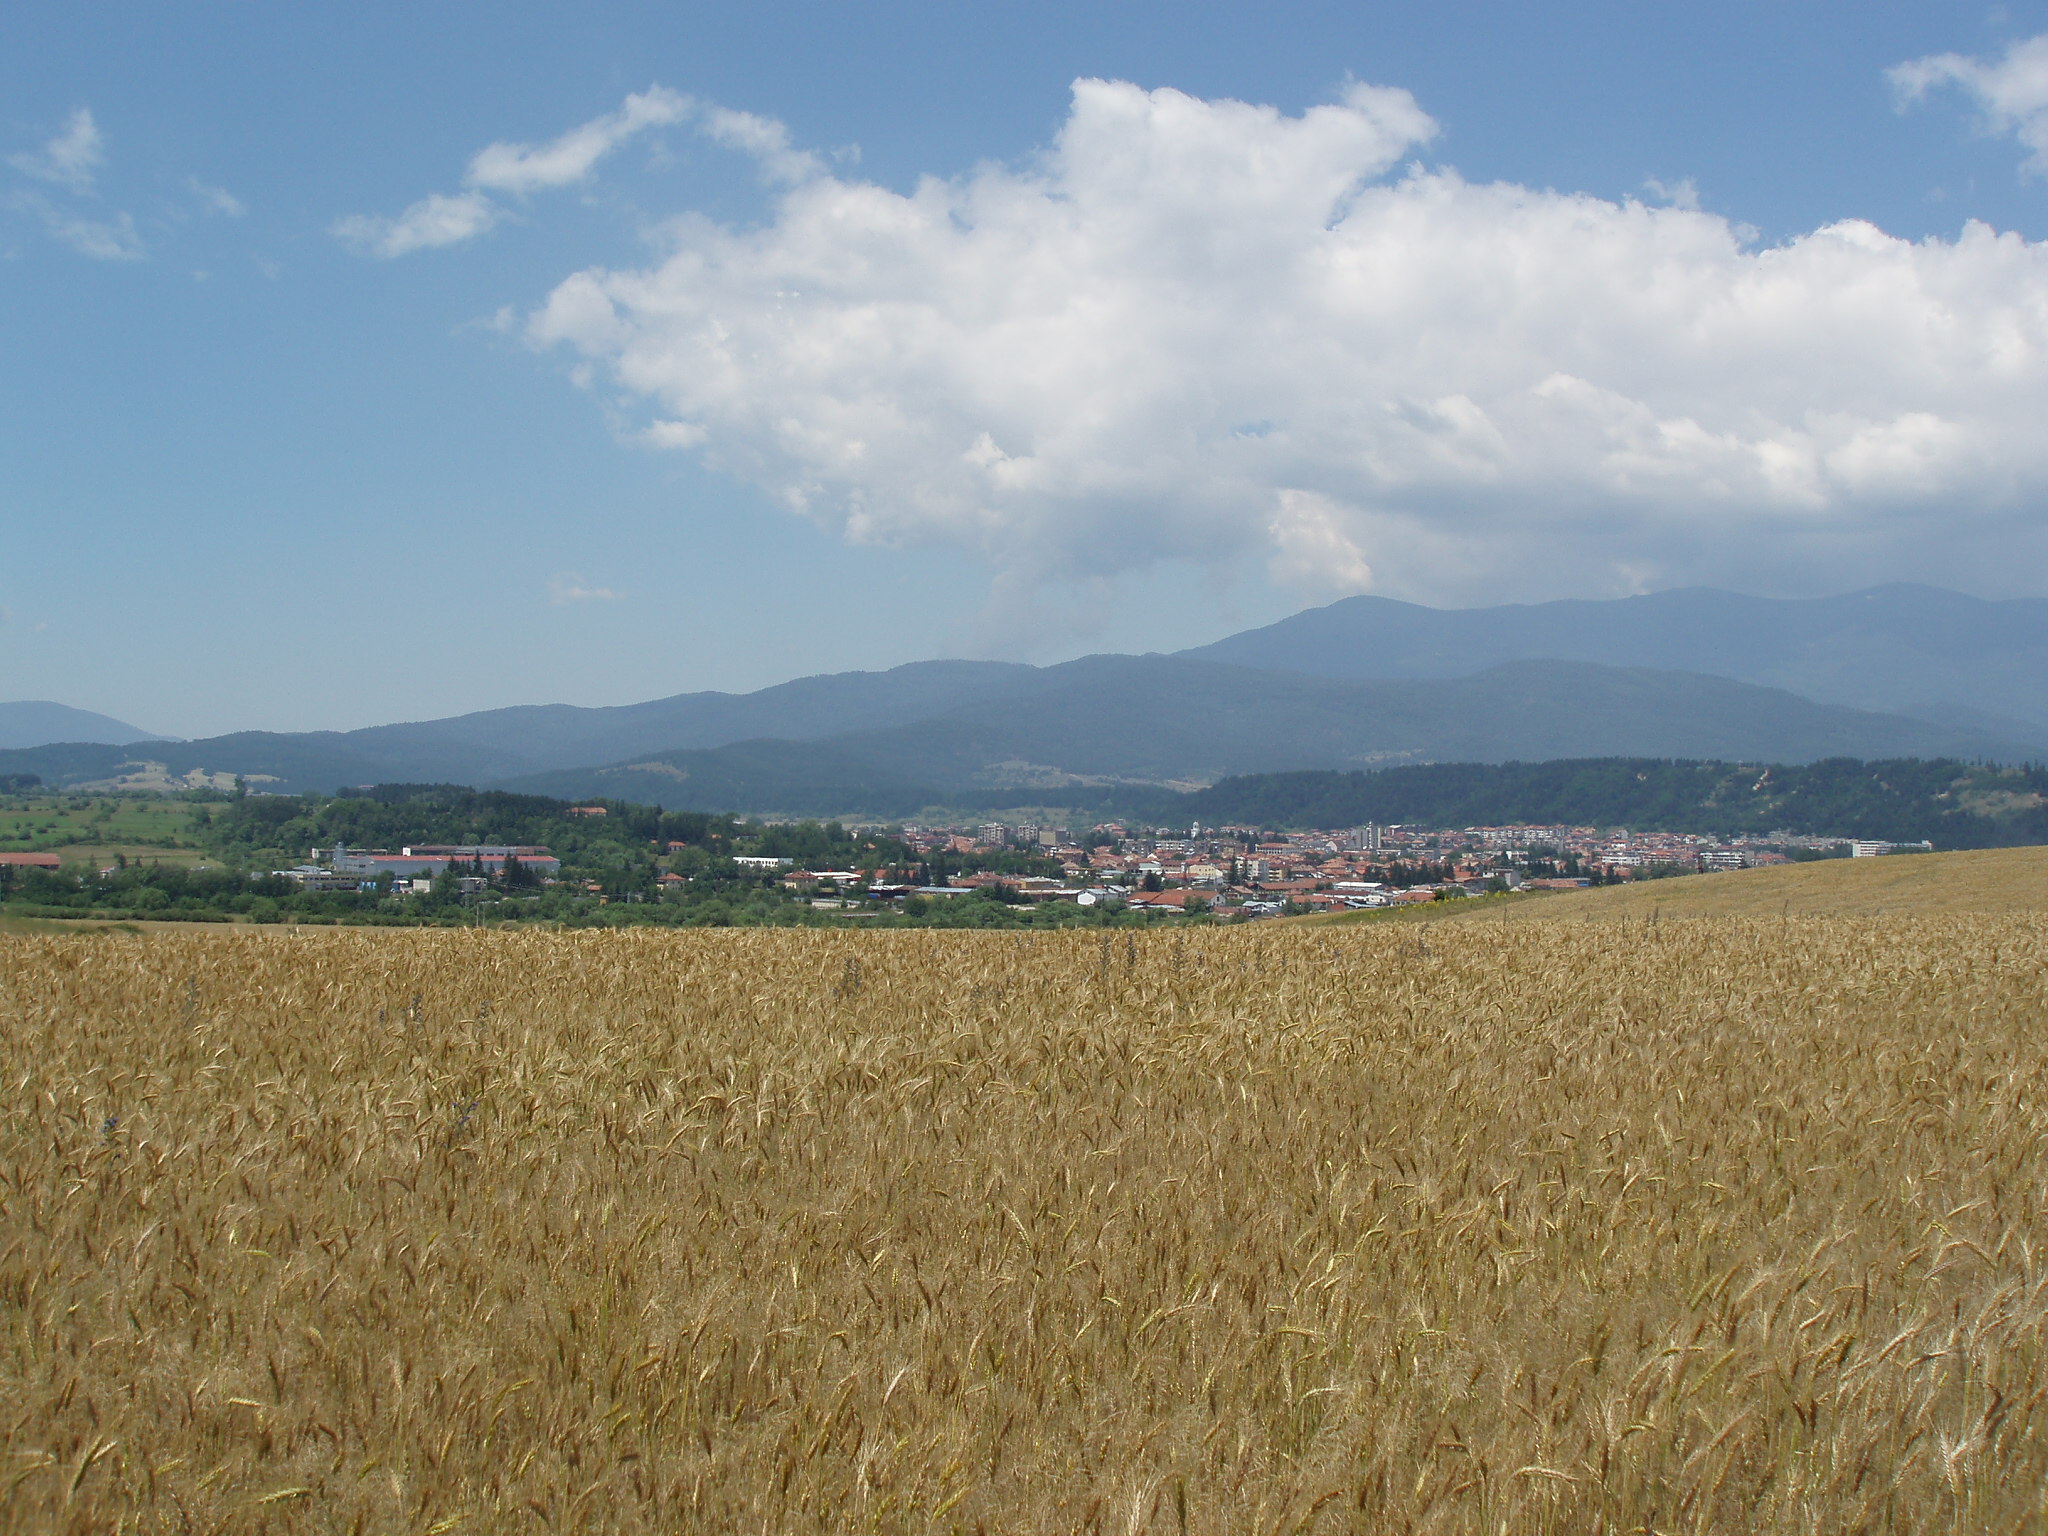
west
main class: Cropland
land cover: Common wheat
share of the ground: > 75 %
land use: Agriculture (excluding fallow land and kitchen gardens)
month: July
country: BG
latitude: 41.8753
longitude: 23.4872
